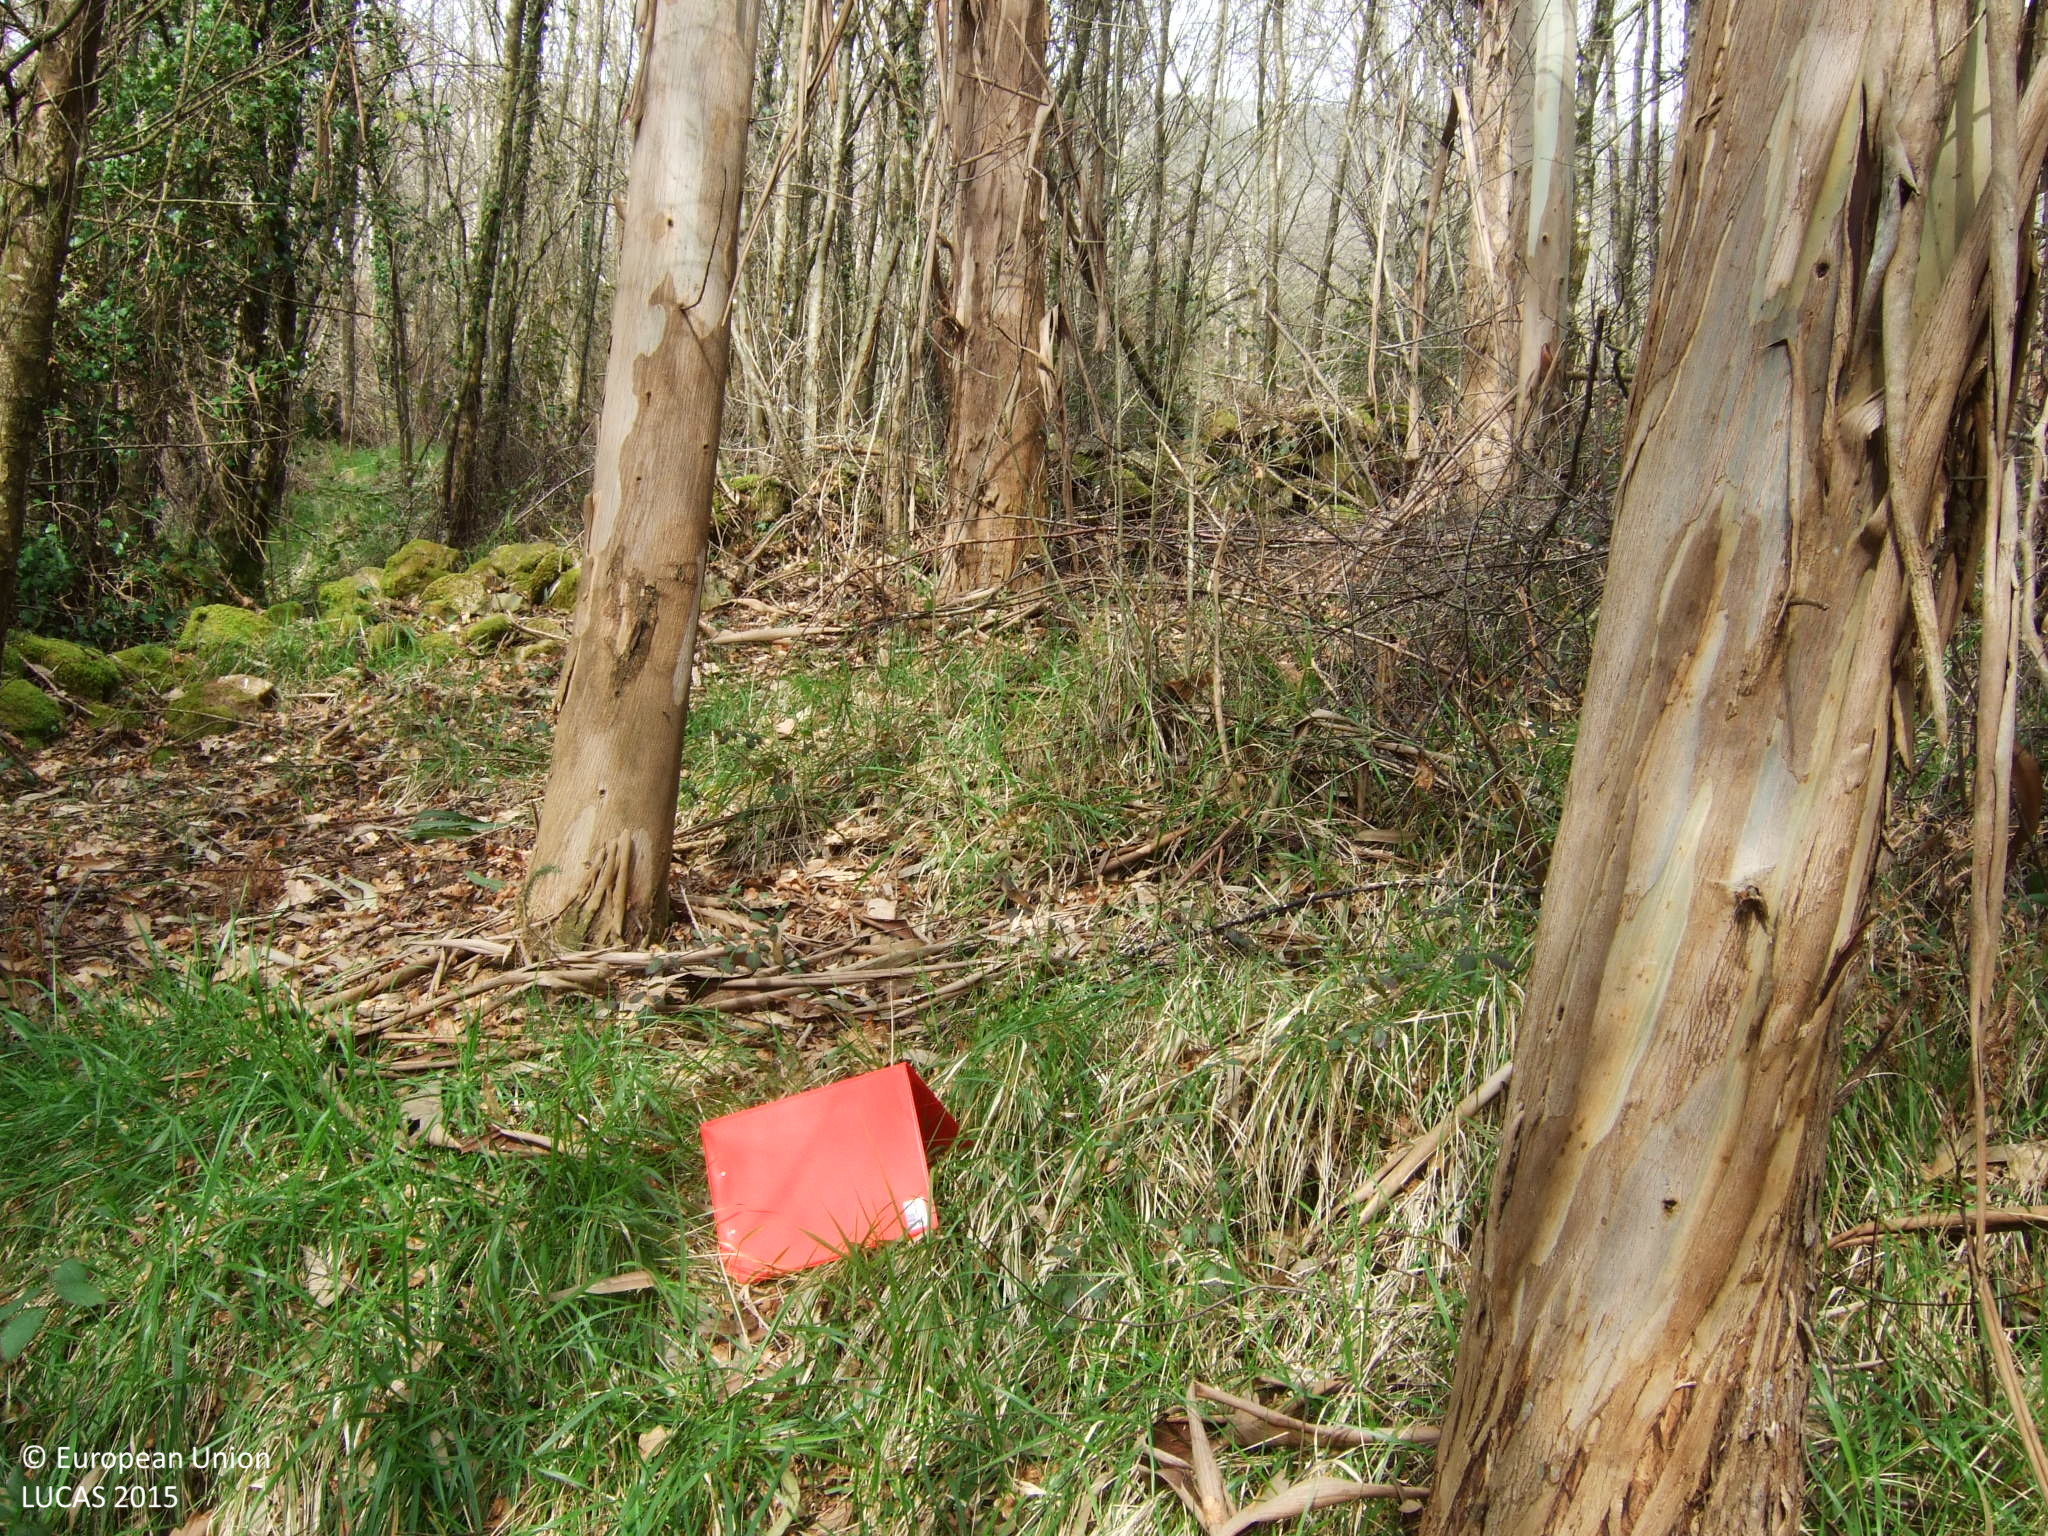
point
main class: Woodland
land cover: Broadleaved woodland
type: exotic forest
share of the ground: > 75 %
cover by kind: broadleaved forest trees 90 %, shrubs 10 %
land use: Forestry
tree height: > 5 m
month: March
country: ES
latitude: 42.9238
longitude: -7.9123
